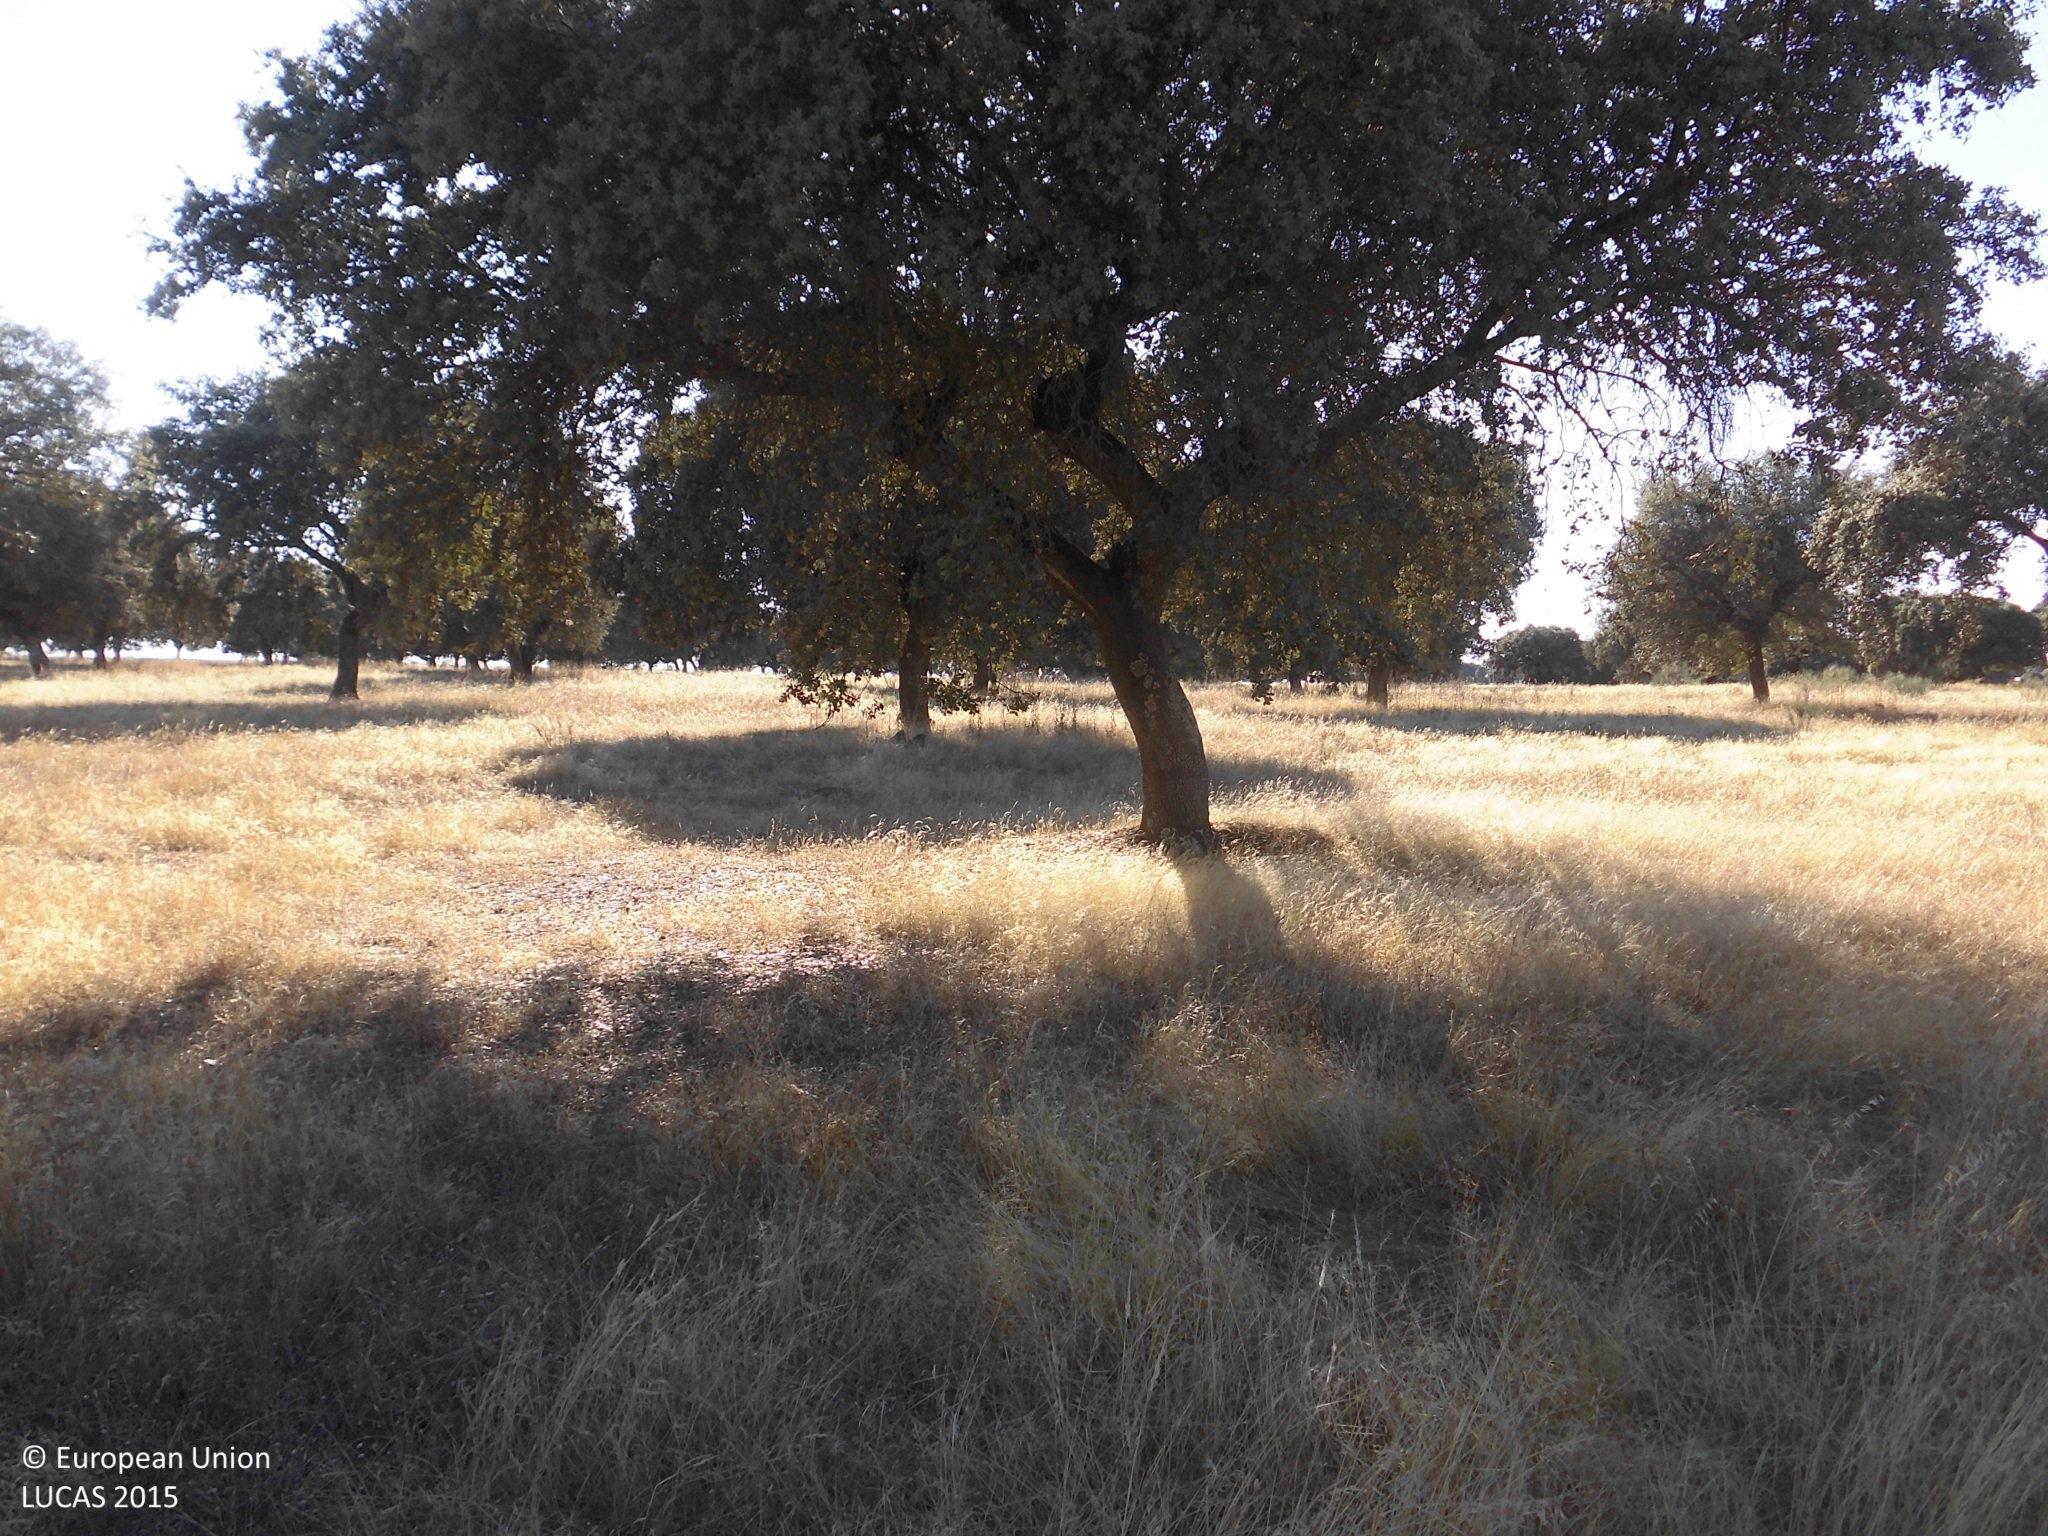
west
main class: Woodland
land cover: Broadleaved woodland
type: broadleaved evergreen forest
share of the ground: 25 - 50 %
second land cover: Grassland without tree/shrub cover
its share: > 75 %
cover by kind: herbaceous plants 65 %, broadleaved forest trees 35 %
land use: Forestry
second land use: Agriculture (excluding fallow land and kitchen gardens)
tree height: > 5 m
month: July
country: ES
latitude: 39.5562
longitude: -5.6390
